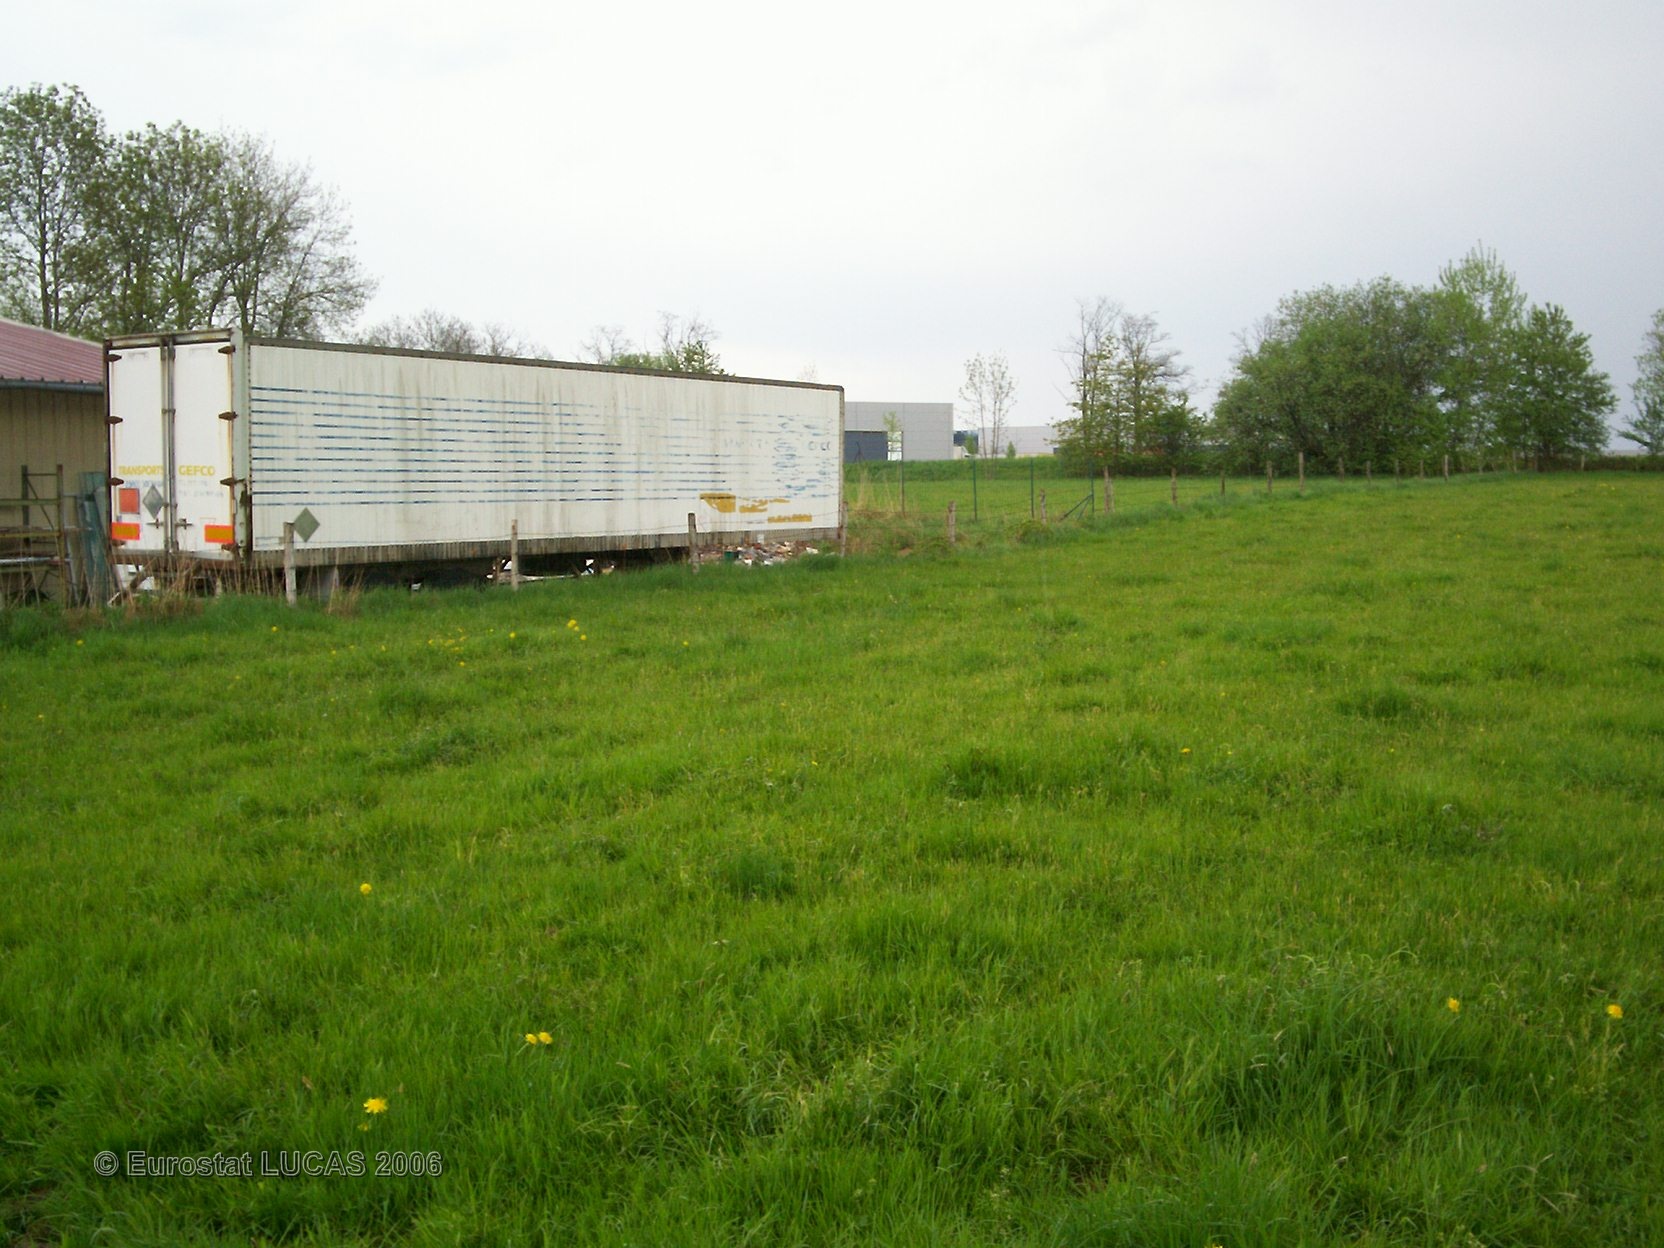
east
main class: Grassland
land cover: Grassland without tree/shrub cover
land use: Agriculture (excluding fallow land and kitchen gardens)
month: May
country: FR
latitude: 47.6606
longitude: 7.0055
